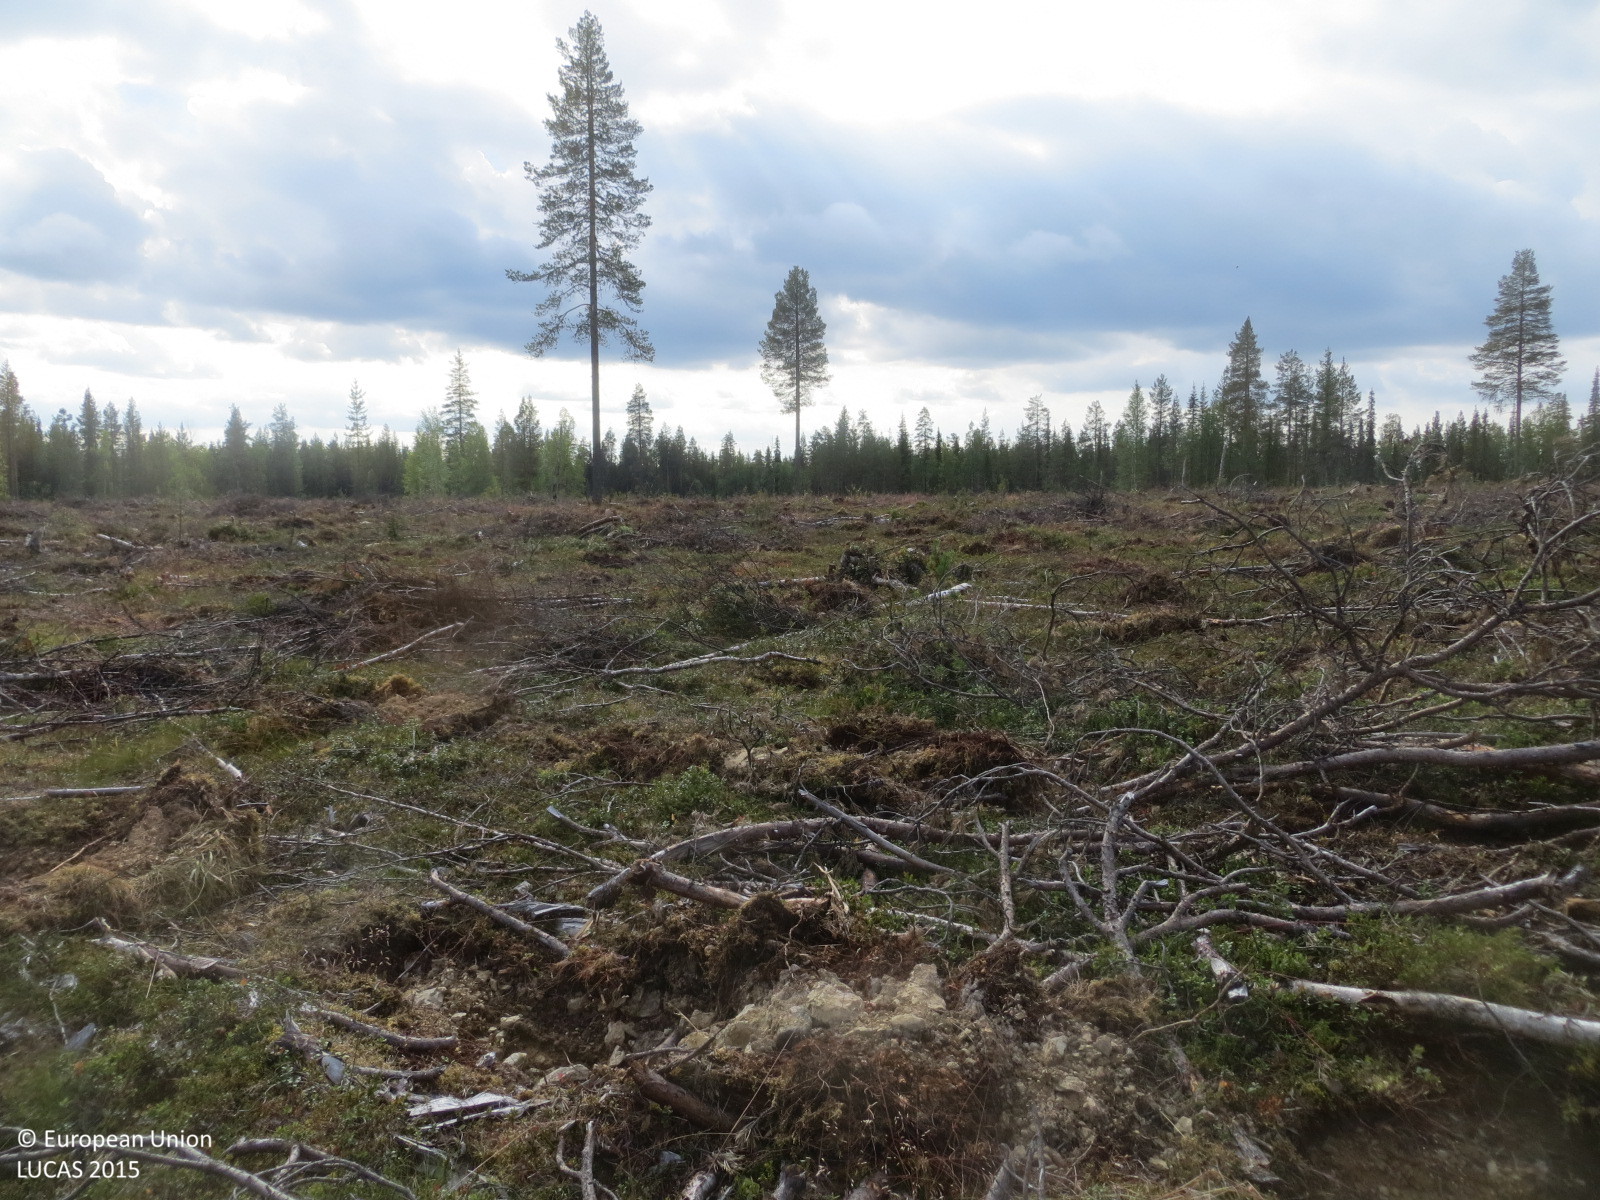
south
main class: Shrubland
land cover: Shrubland with sparse tree cover
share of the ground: > 75 %
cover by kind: shrubs 70 %, unconsolidated bare surface 10 %, coniferous forest trees 5 %, consolidated bare surface 5 %
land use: Forestry
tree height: > 5 m
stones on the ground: 25 - 50 %
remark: Clear cut
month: August
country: FI
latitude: 67.9312
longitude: 25.4728
